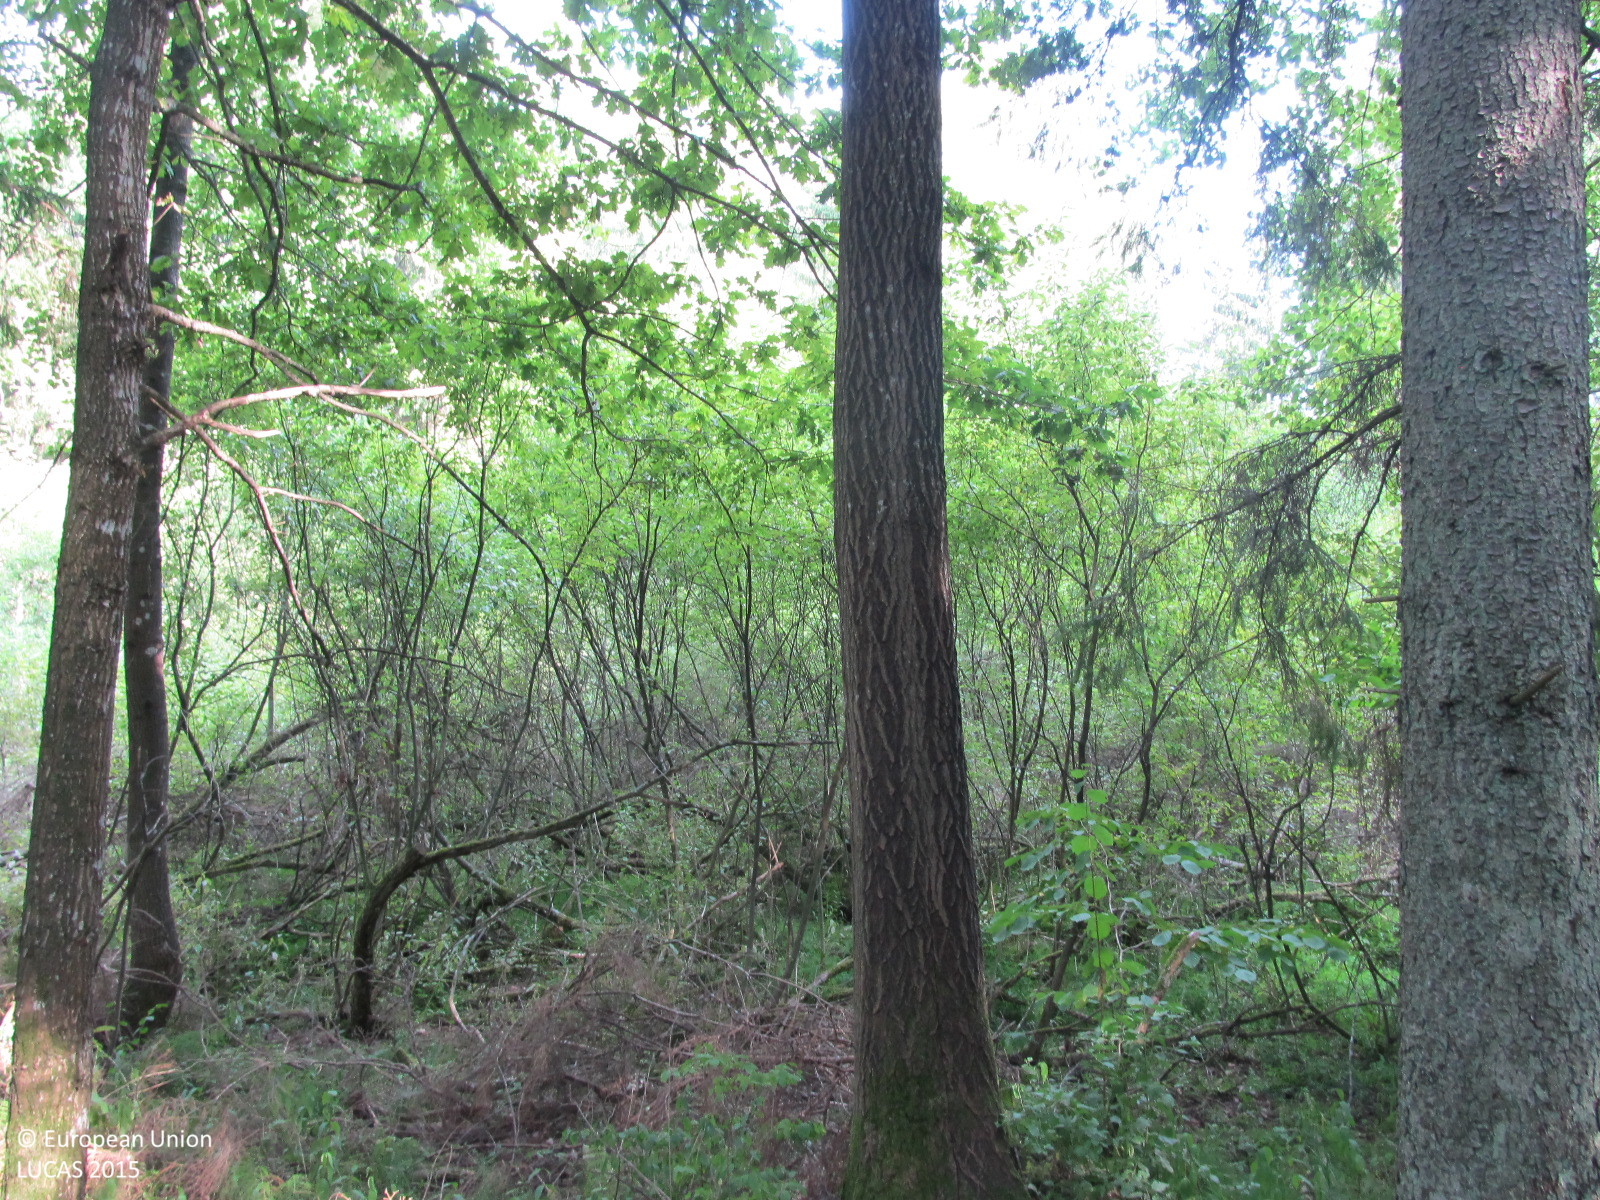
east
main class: Woodland
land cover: Spruce dominated mixed woodland
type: hemiboreal forest and nemoral coniferous forest and mixed broadleaved-coniferous forest
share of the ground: 50 - 75 %
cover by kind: coniferous forest trees 45 %, broadleaved forest trees 25 %, herbaceous plants 20 %, shrubs 10 %
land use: Forestry
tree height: > 5 m
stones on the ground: < 10 %
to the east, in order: Spruce dominated mixed woodland; Ditches and canals; Other mixed woodland; Inland marshes; Broadleaved woodland; Spruce dominated mixed woodland
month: August
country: LT
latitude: 55.7574
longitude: 23.0243
